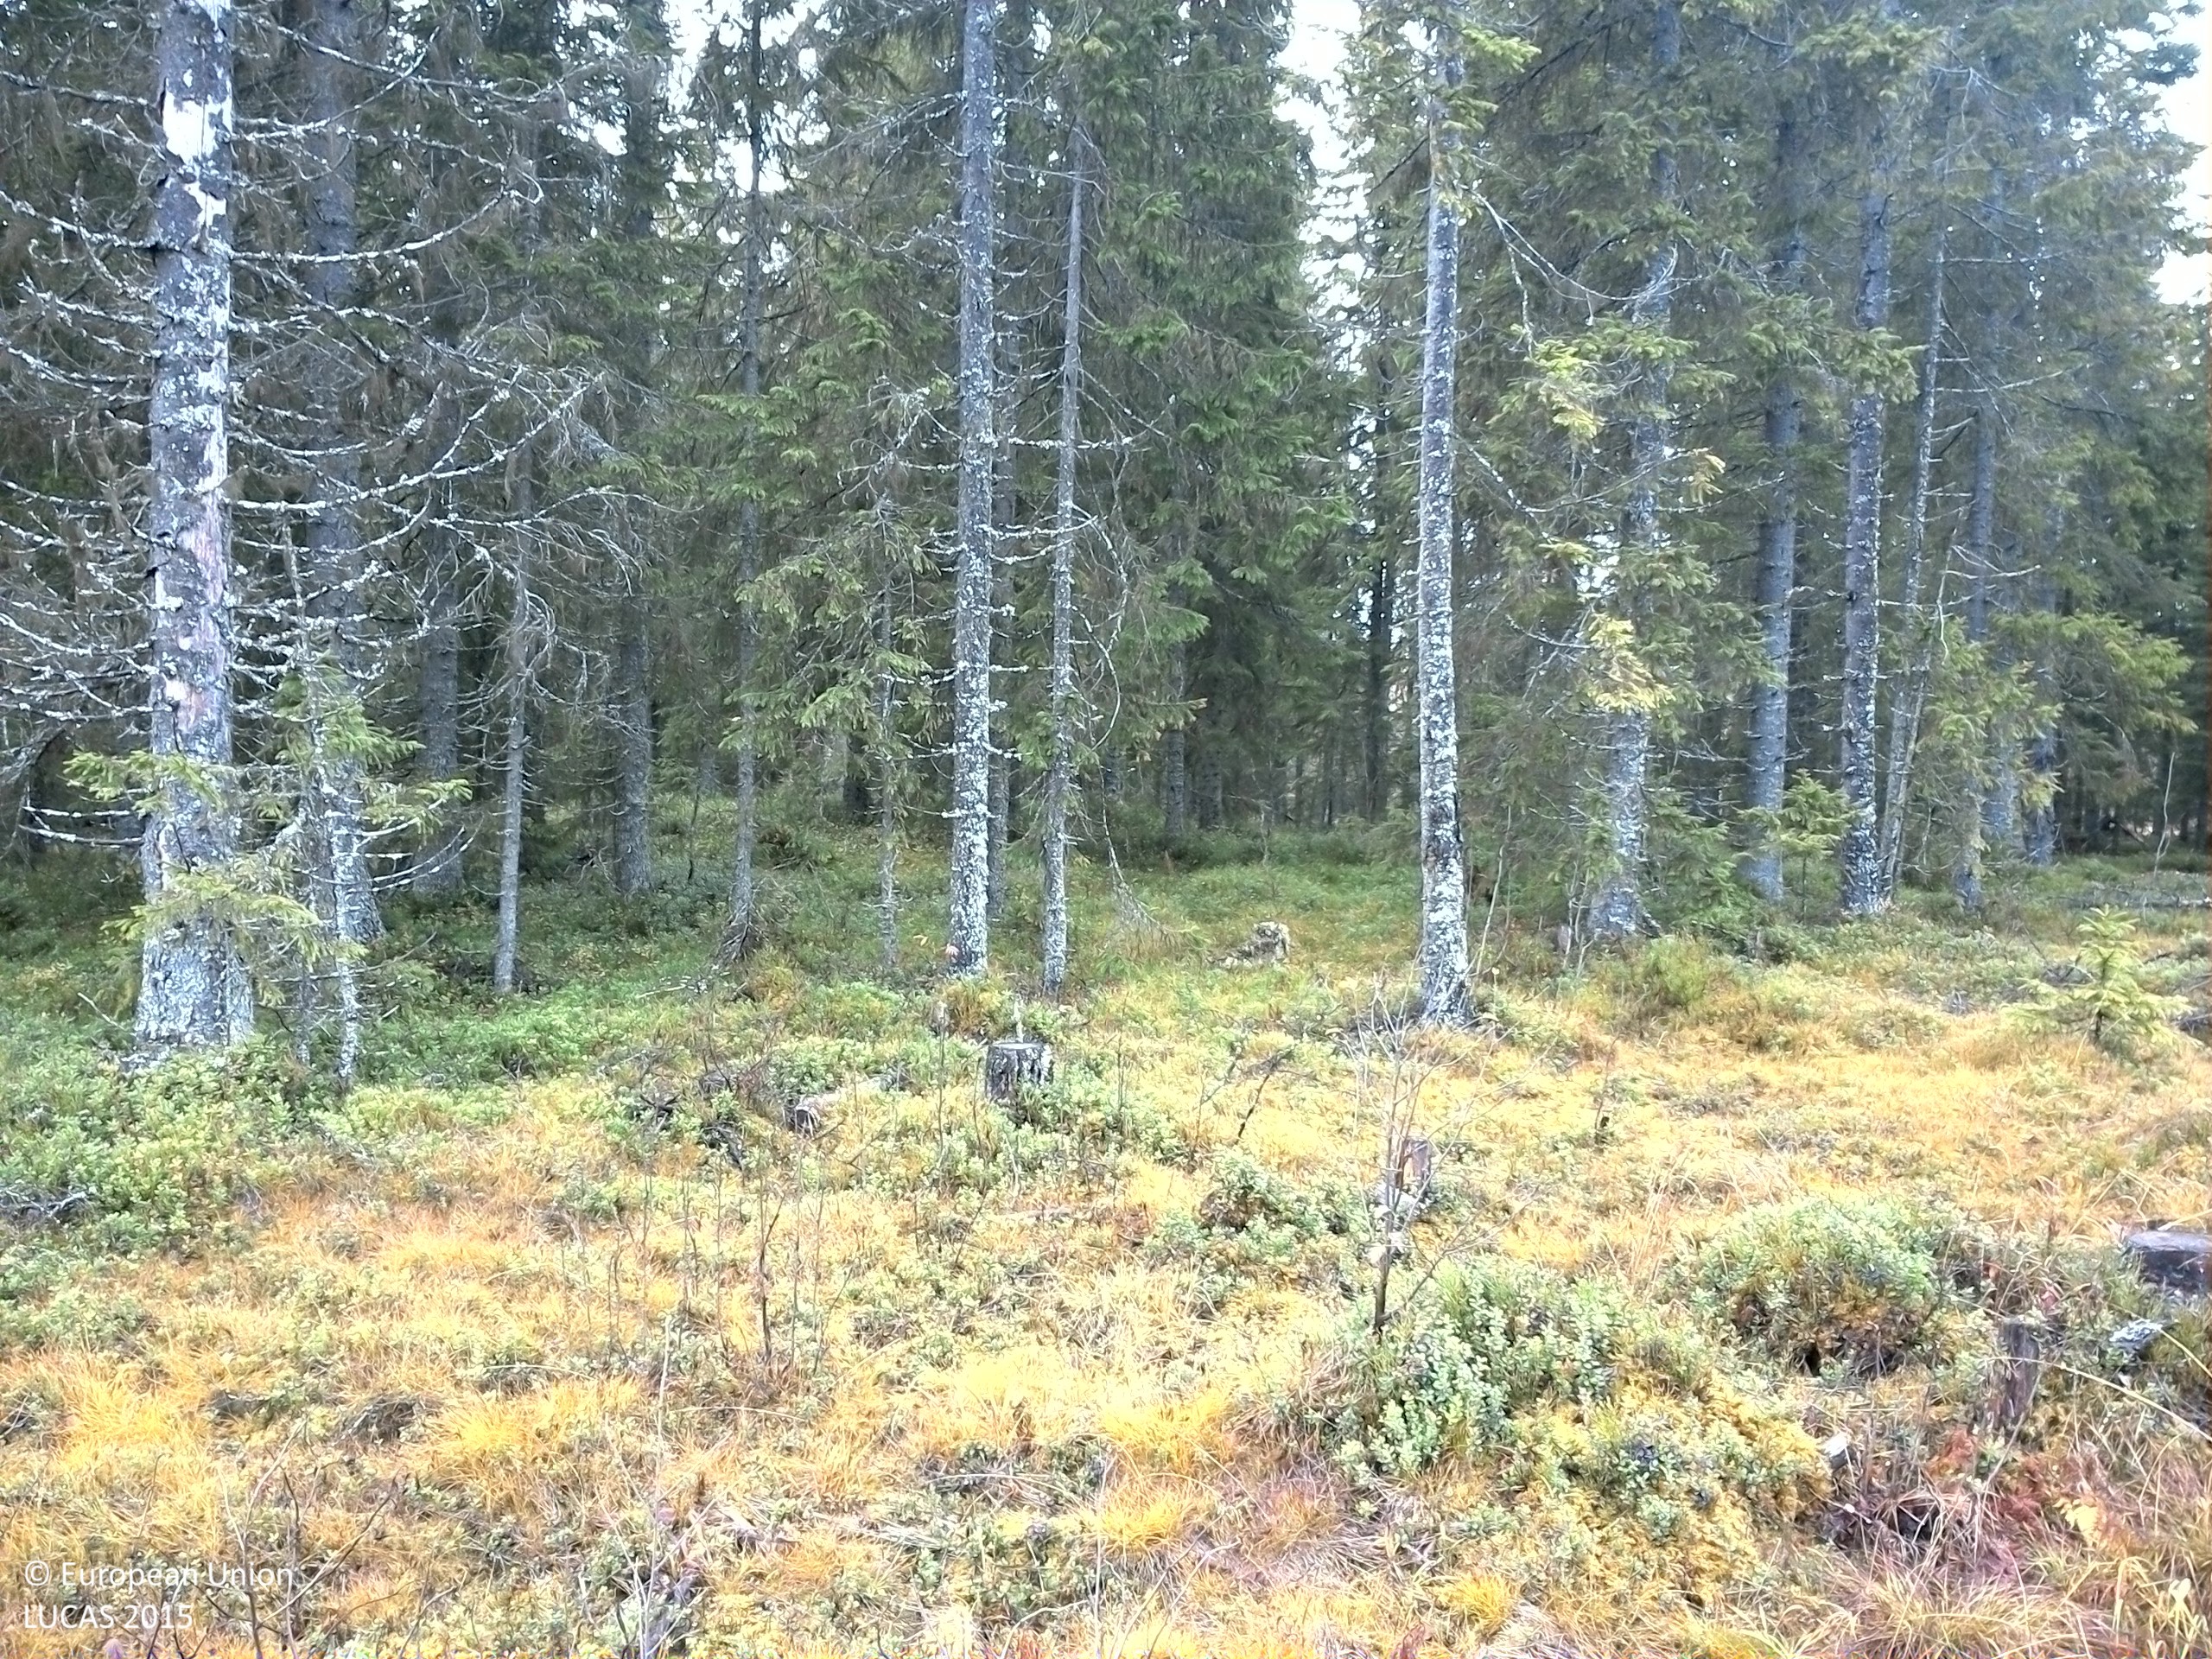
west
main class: Woodland
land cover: Broadleaved woodland
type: boreal forest
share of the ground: > 75 %
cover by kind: herbaceous plants 80 %, broadleaved forest trees 10 %, unconsolidated bare surface 10 %
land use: Forestry
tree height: < 5 m
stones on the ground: 10 - 25 %
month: October
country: SE
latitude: 63.7458
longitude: 15.3842
